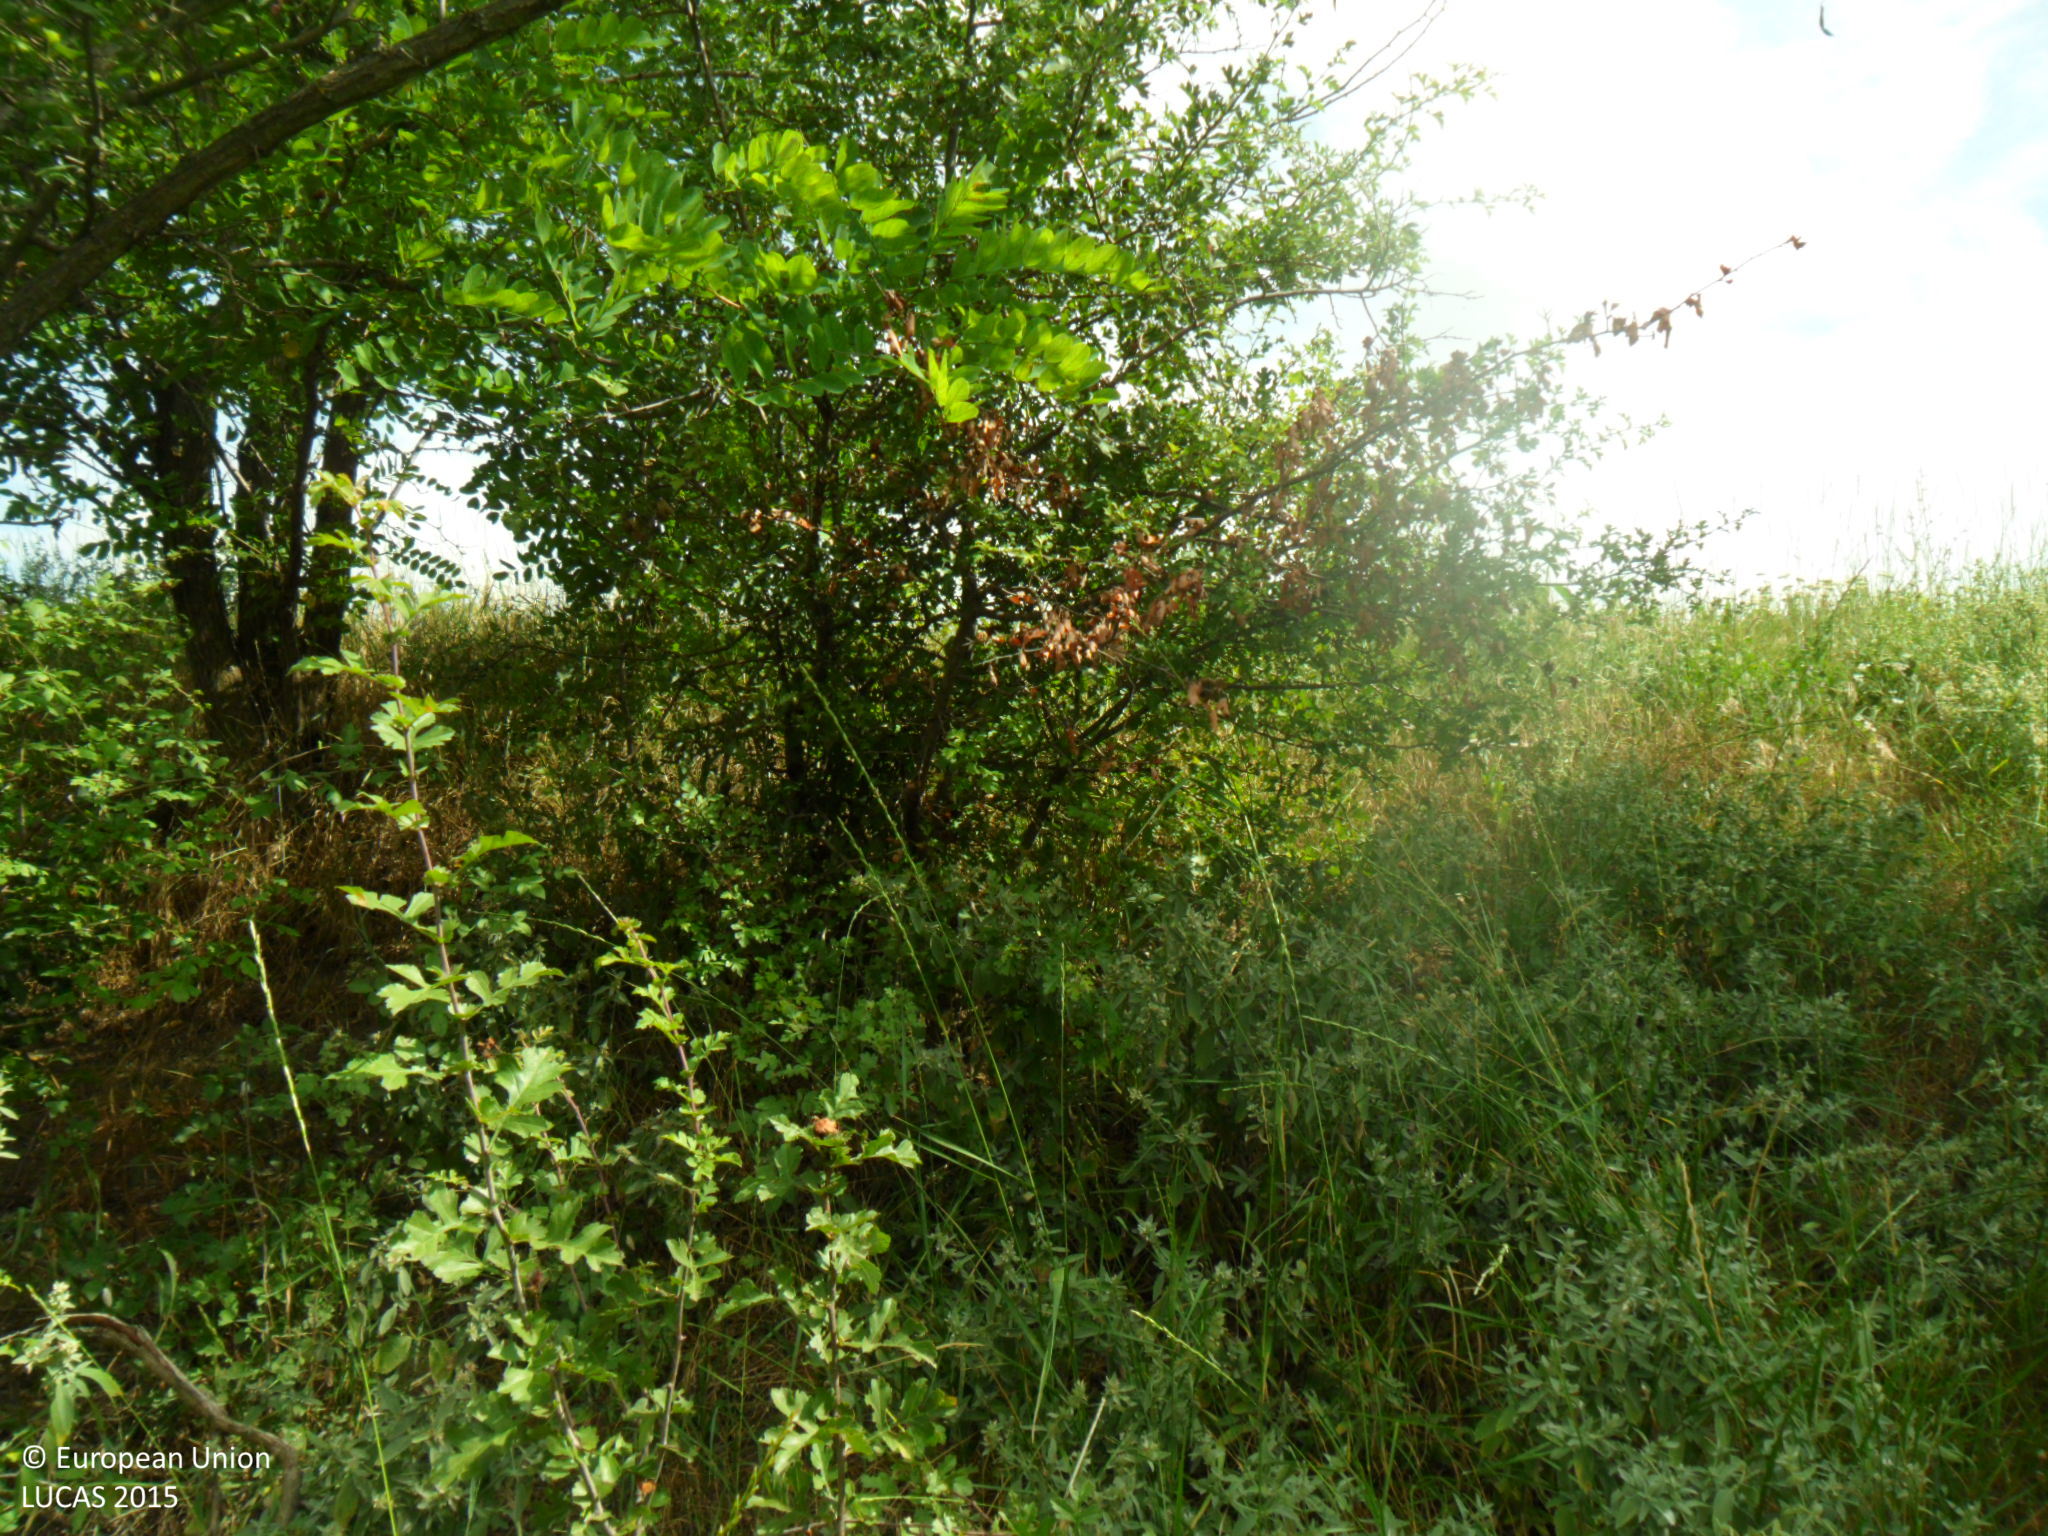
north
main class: Shrubland
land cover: Shrubland with sparse tree cover
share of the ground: > 75 %
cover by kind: shrubs 90 %, broadleaved forest trees 5 %, herbaceous plants 5 %
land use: Semi-natural and natural areas not in use
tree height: < 5 m
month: July
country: BG
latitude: 43.3812
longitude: 27.1919
